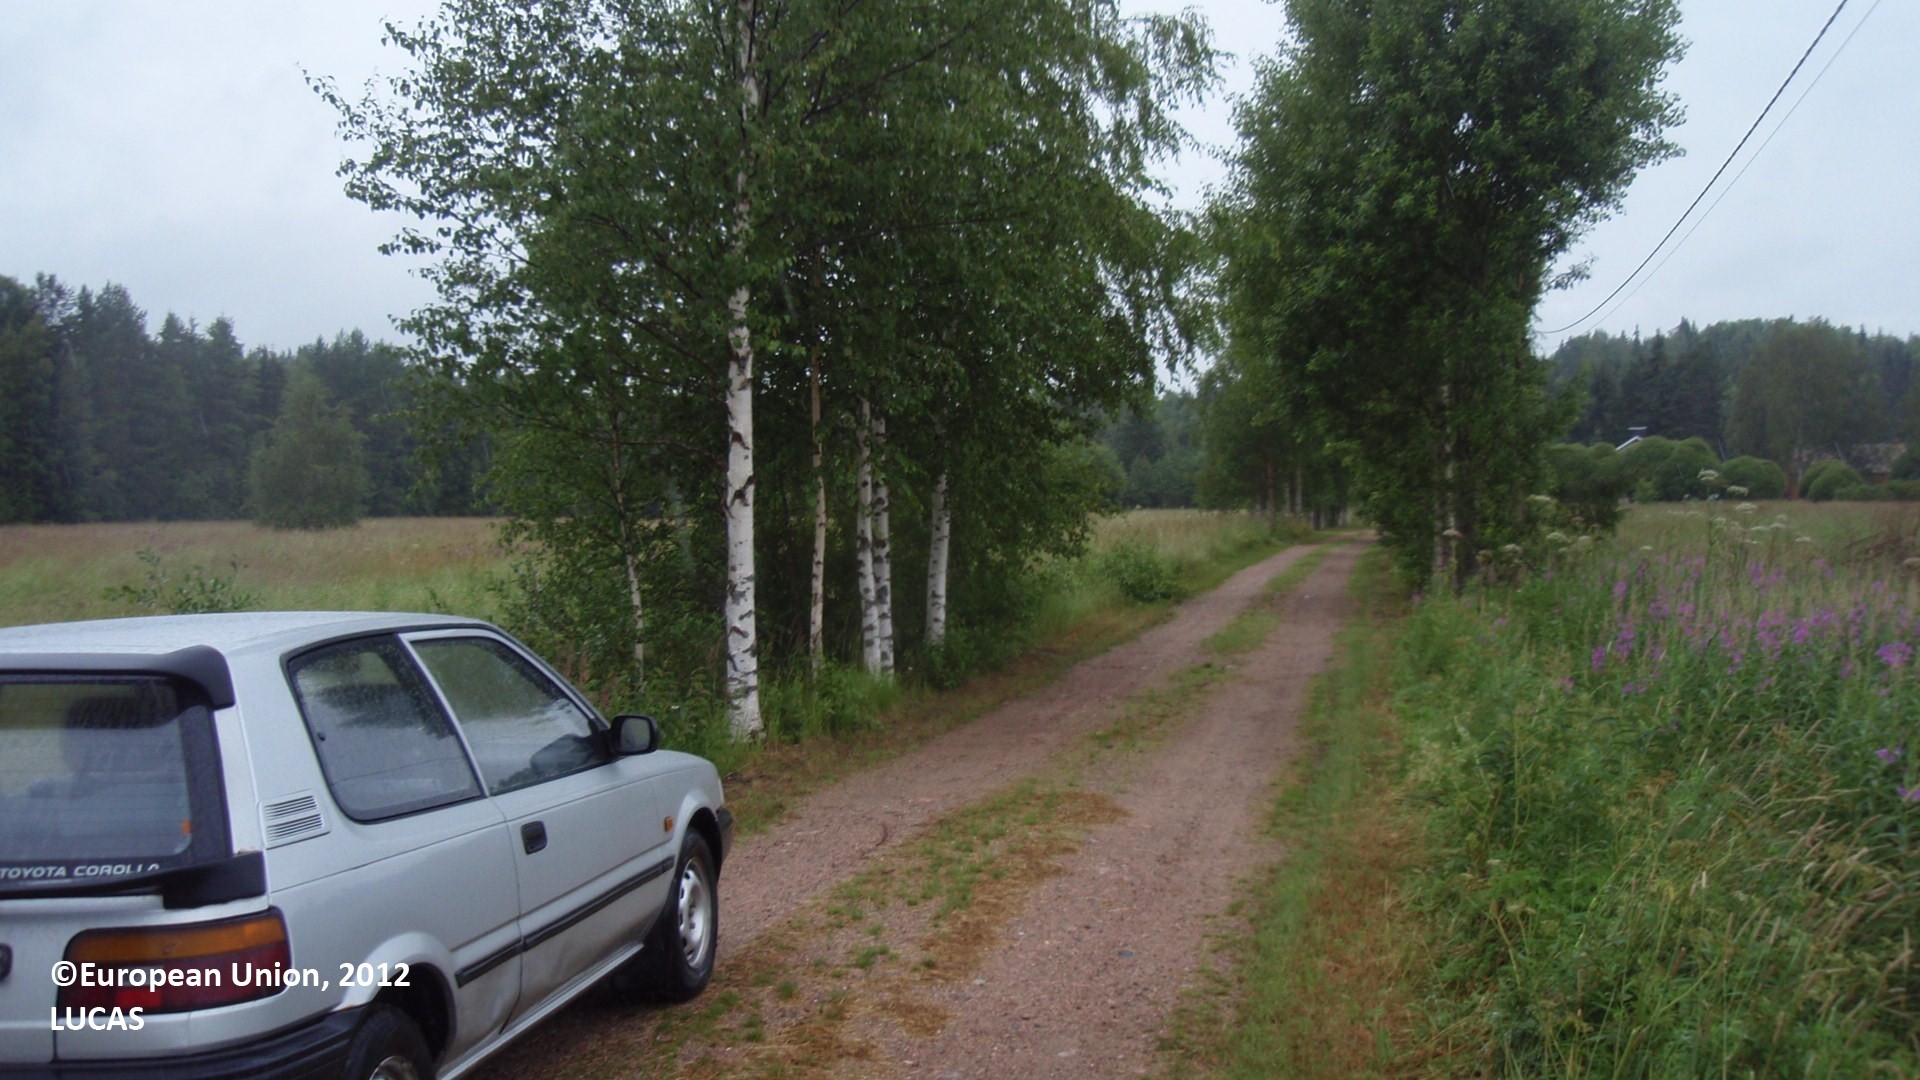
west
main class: Cropland
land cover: Oats
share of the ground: > 75 %
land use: Agriculture (excluding fallow land and kitchen gardens)
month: July
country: FI
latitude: 61.0987
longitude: 28.7551
